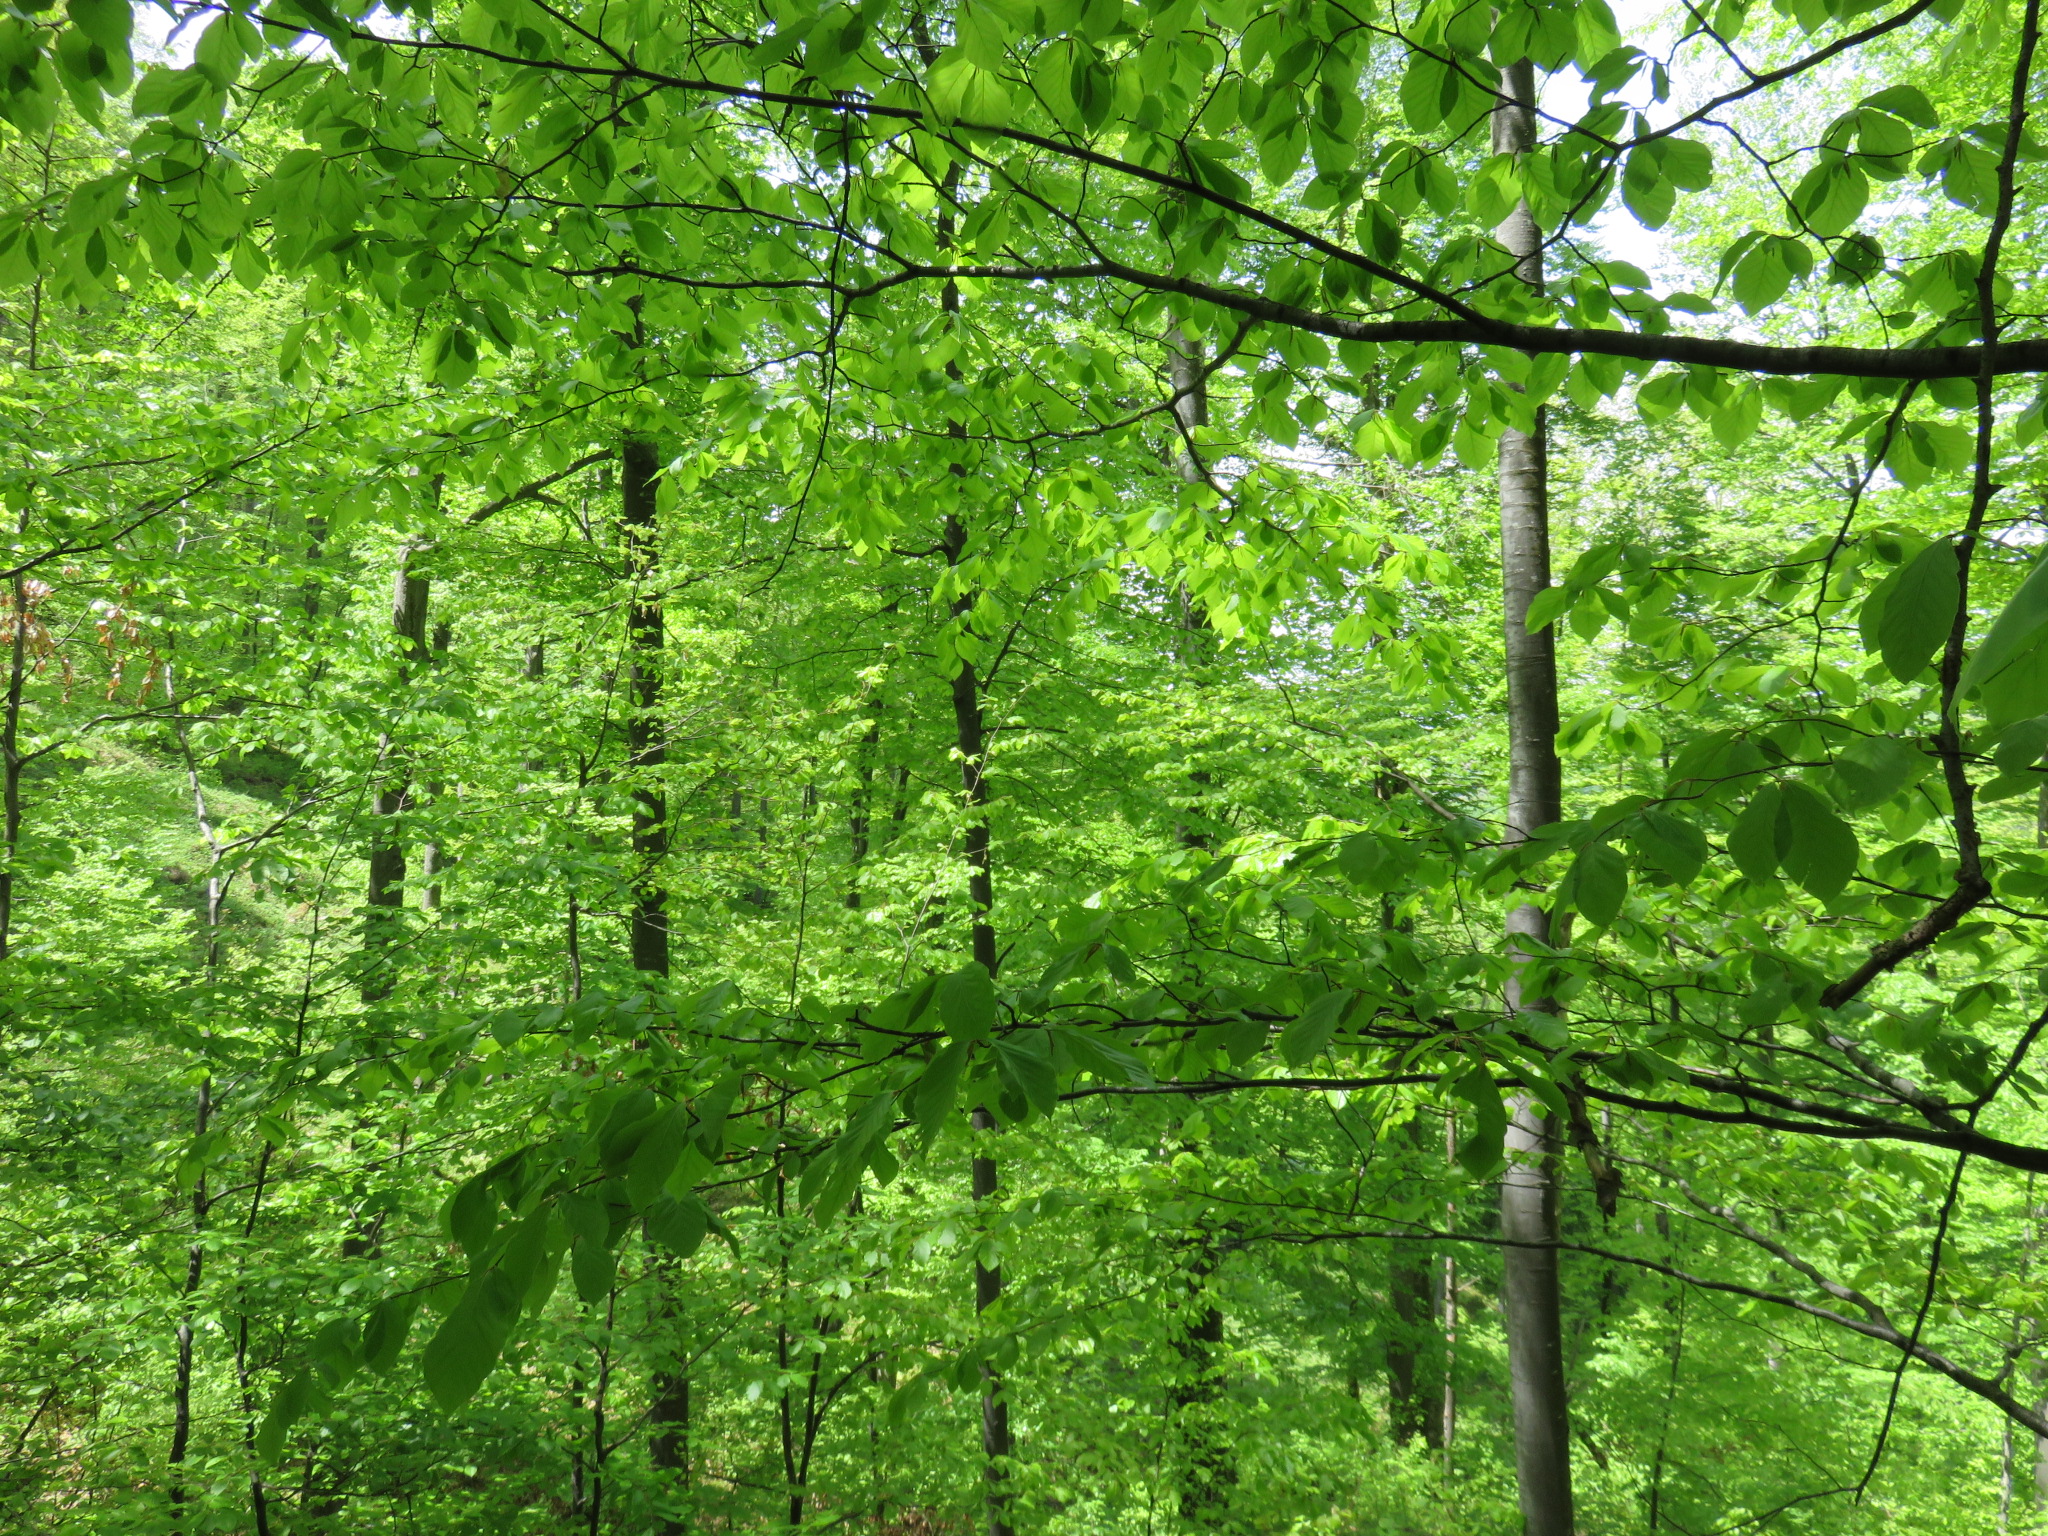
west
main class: Woodland
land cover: Broadleaved woodland
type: beech forest
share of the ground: > 75 %
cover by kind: broadleaved forest trees 85 %, unconsolidated bare surface 15 %
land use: Forestry
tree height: > 5 m
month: May
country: BG
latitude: 42.8386
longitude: 24.8281
